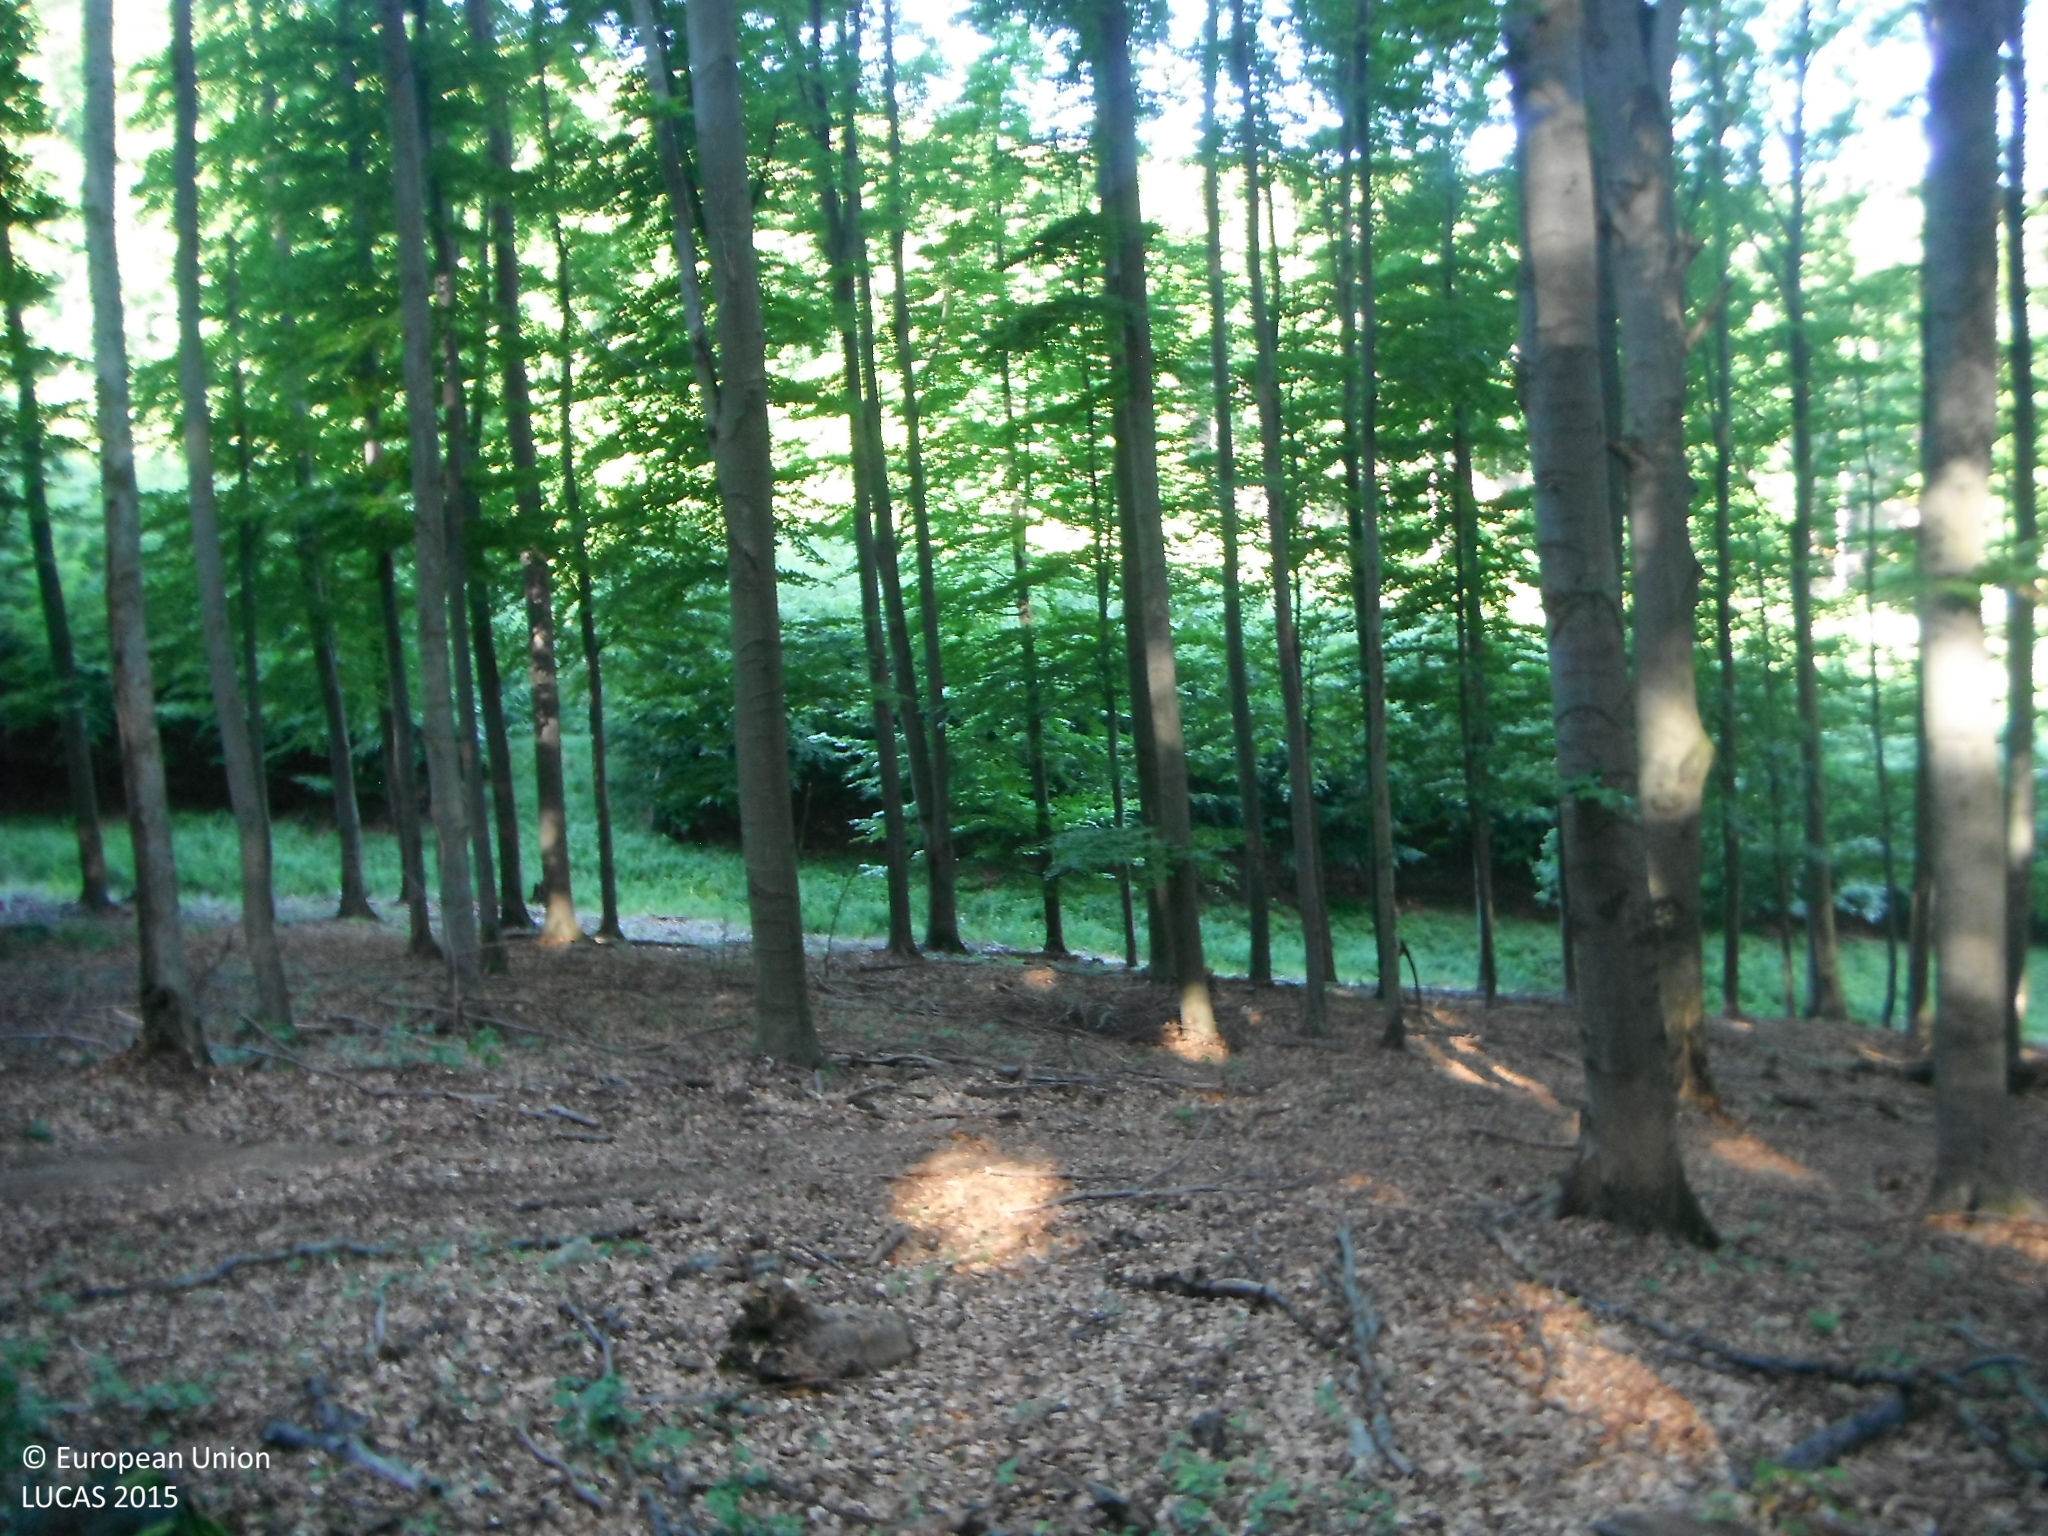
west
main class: Woodland
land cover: Broadleaved woodland
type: beech forest
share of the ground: > 75 %
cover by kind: broadleaved forest trees 80 %, shrubs 15 %, unconsolidated bare surface 5 %
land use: Forestry
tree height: > 5 m
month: June
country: SK
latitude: 48.5061
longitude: 18.3127
